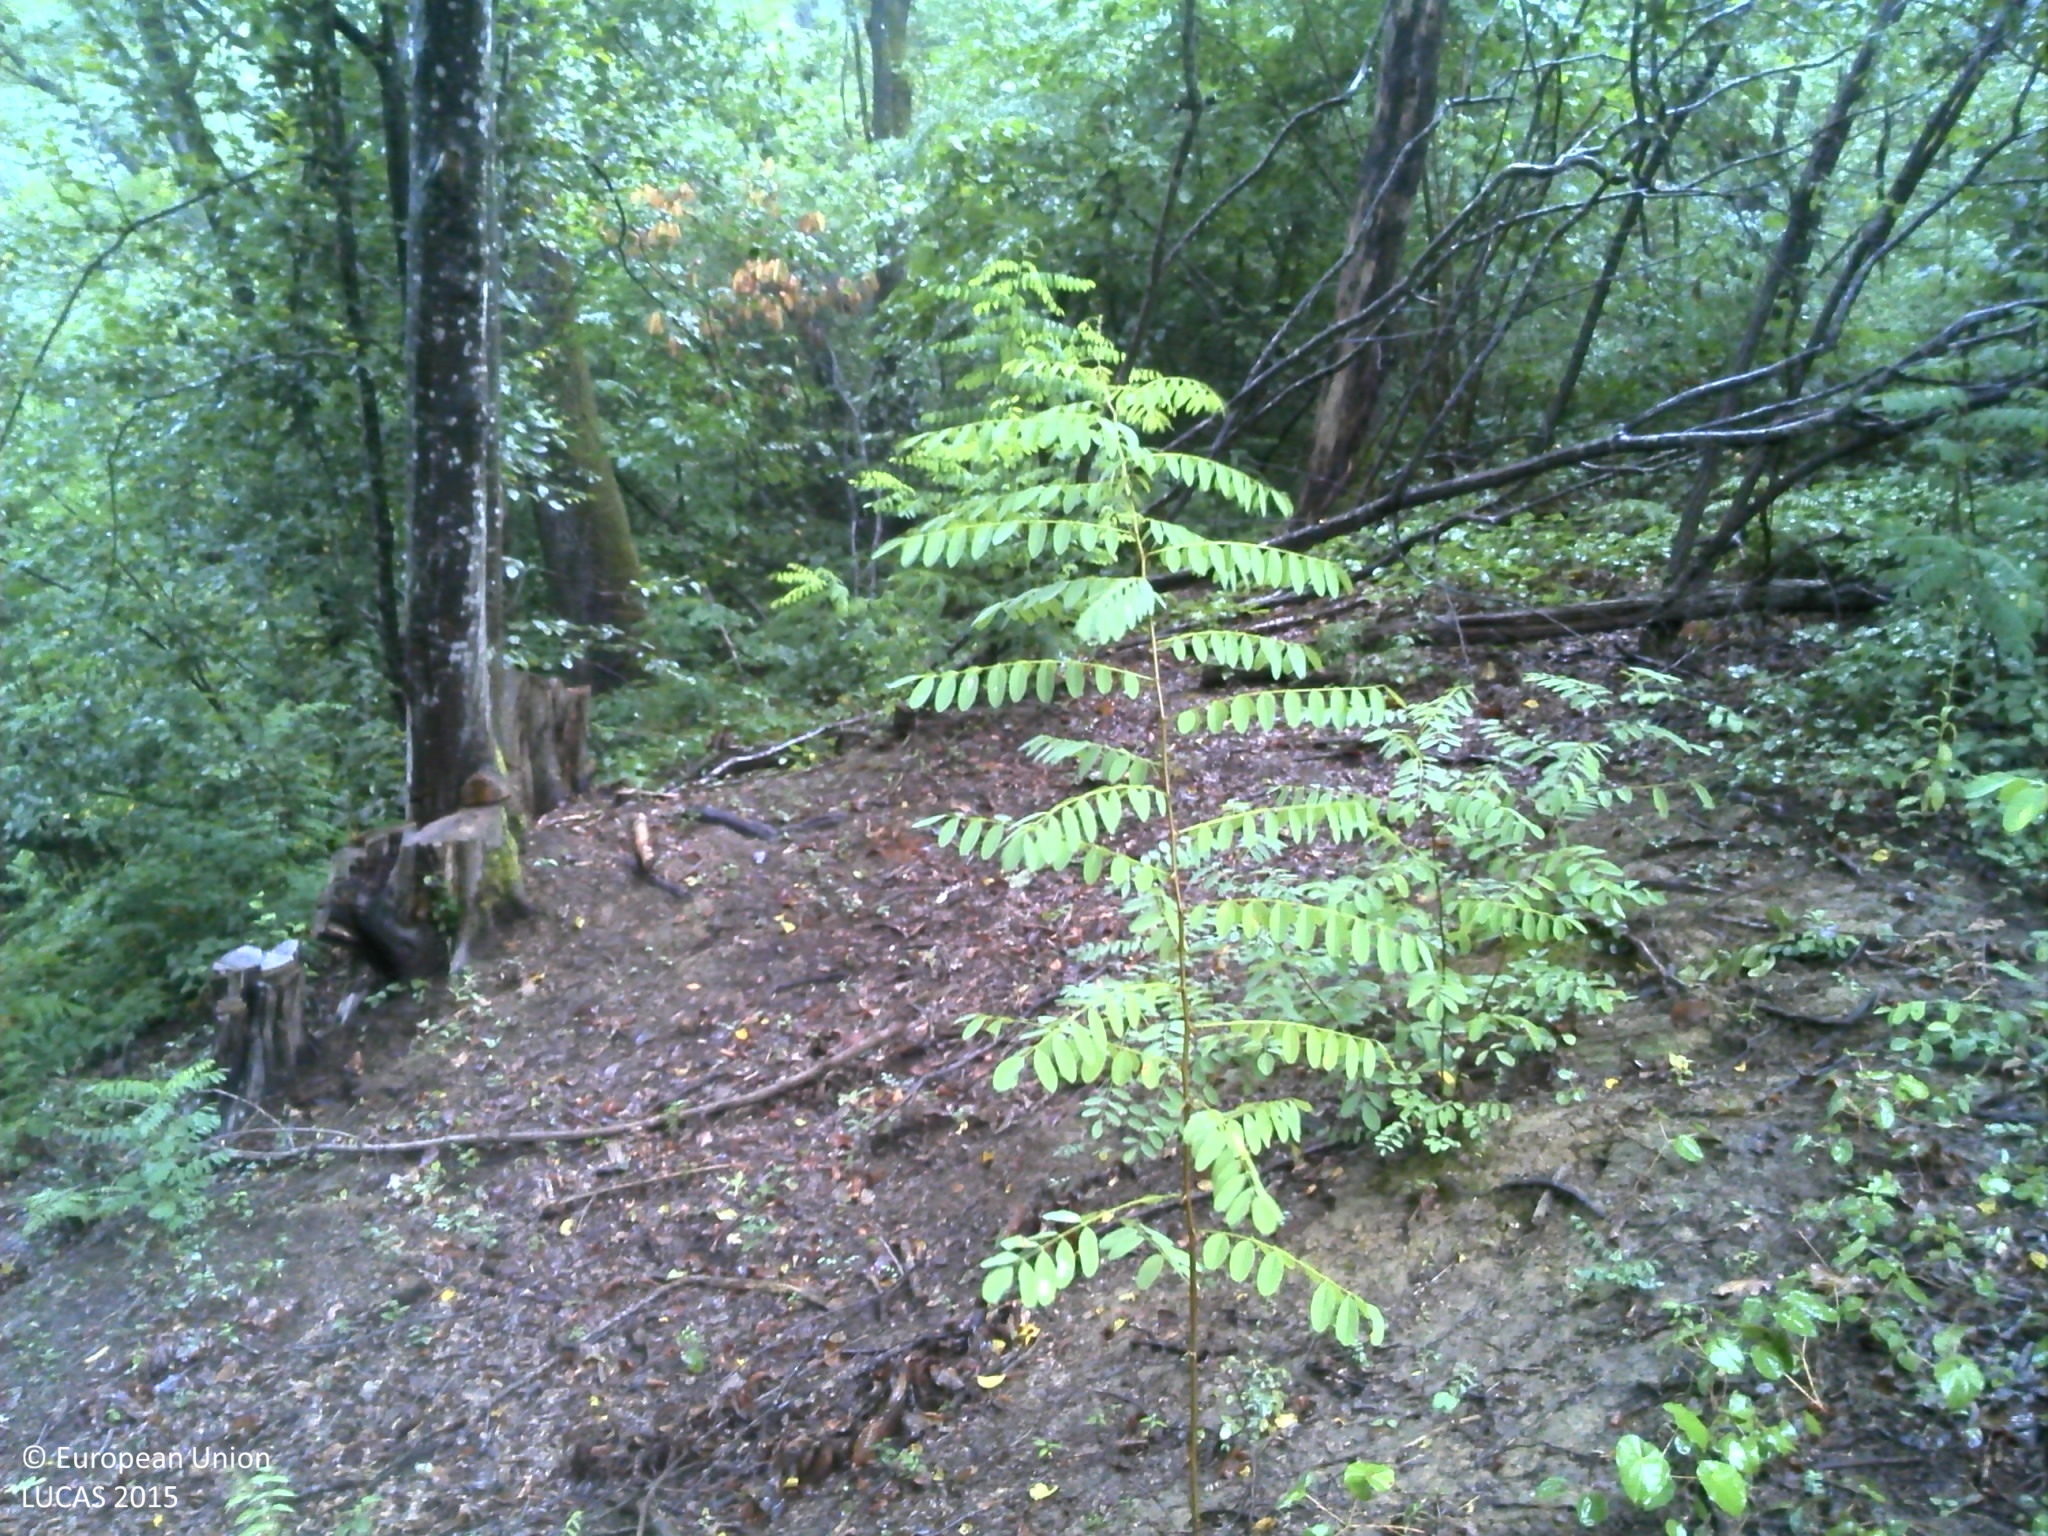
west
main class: Woodland
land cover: Broadleaved woodland
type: beech forest
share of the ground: > 75 %
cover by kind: broadleaved forest trees 100 %
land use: Forestry
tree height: > 5 m
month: August
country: HR
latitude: 45.4761
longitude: 15.7146
